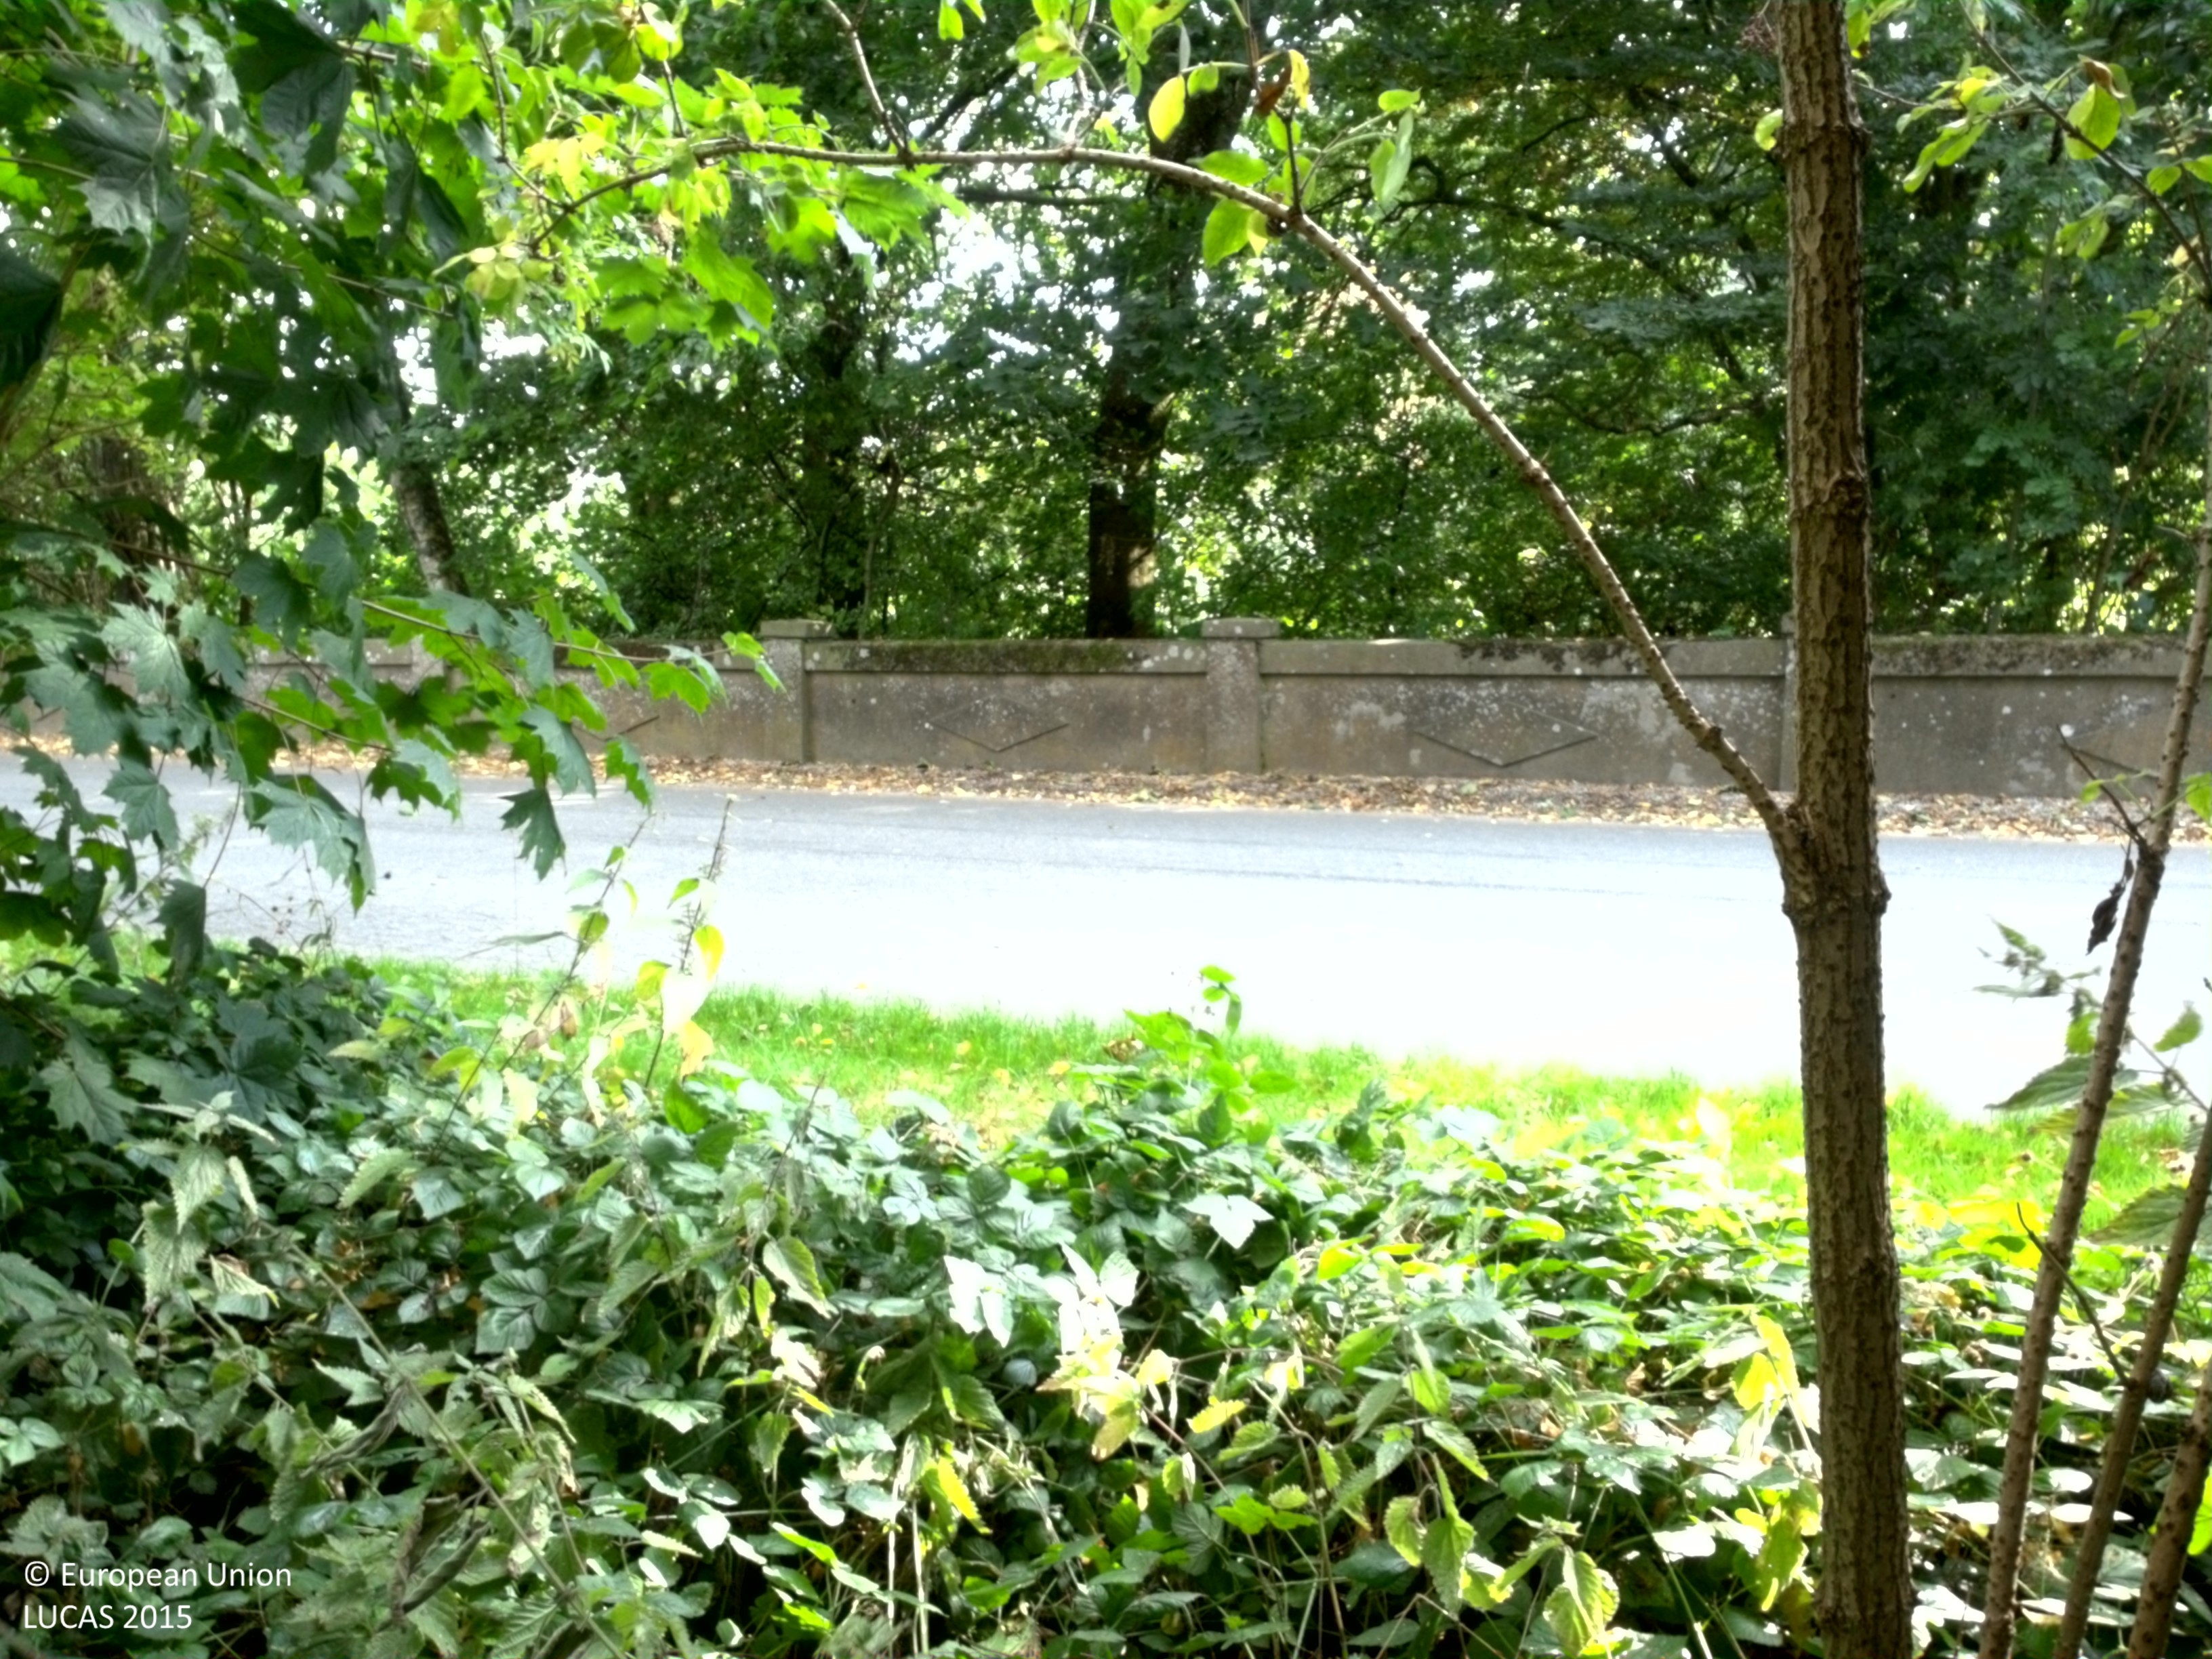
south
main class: Woodland
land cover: Broadleaved woodland
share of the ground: > 75 %
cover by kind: broadleaved forest trees 75 %, herbaceous plants 15 %, shrubs 10 %
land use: Residential
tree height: > 5 m
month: September
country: SE
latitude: 55.5262
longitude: 14.1649
